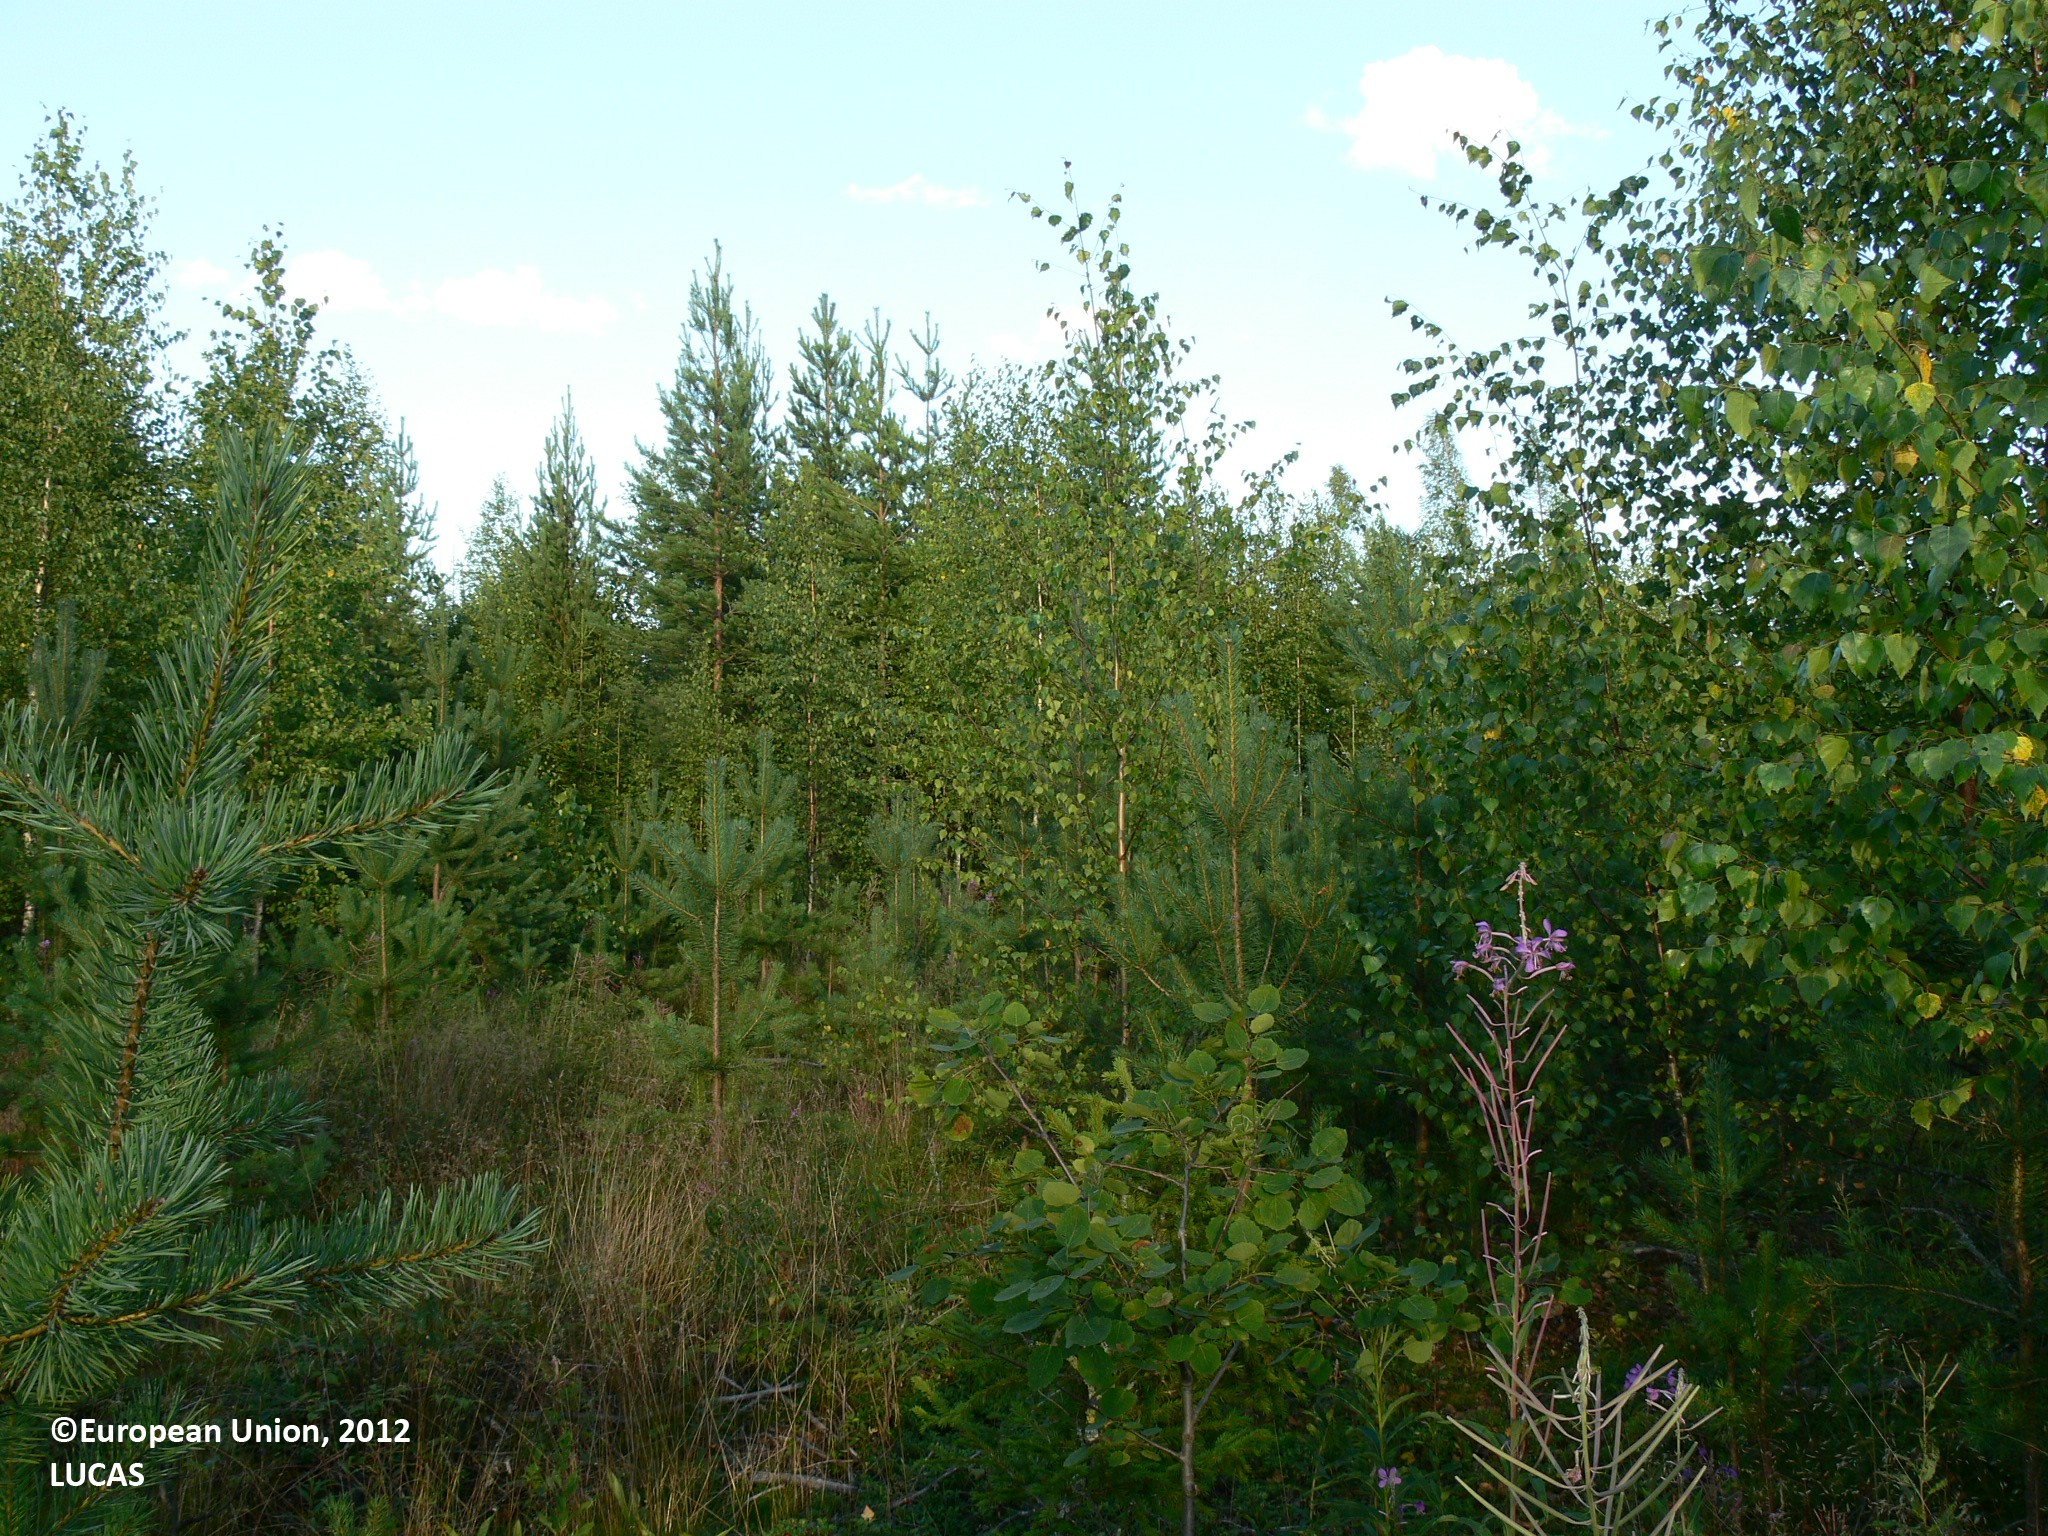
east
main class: Woodland
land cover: Pine dominated mixed woodland
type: boreal forest
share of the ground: 25 - 50 %
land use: Forestry
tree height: < 5 m
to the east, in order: Pine dominated mixed woodland; Spruce dominated mixed woodland; Other bare soil; Ditches and canals; Other bare soil
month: August
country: FI
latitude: 61.9582
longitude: 29.1665
